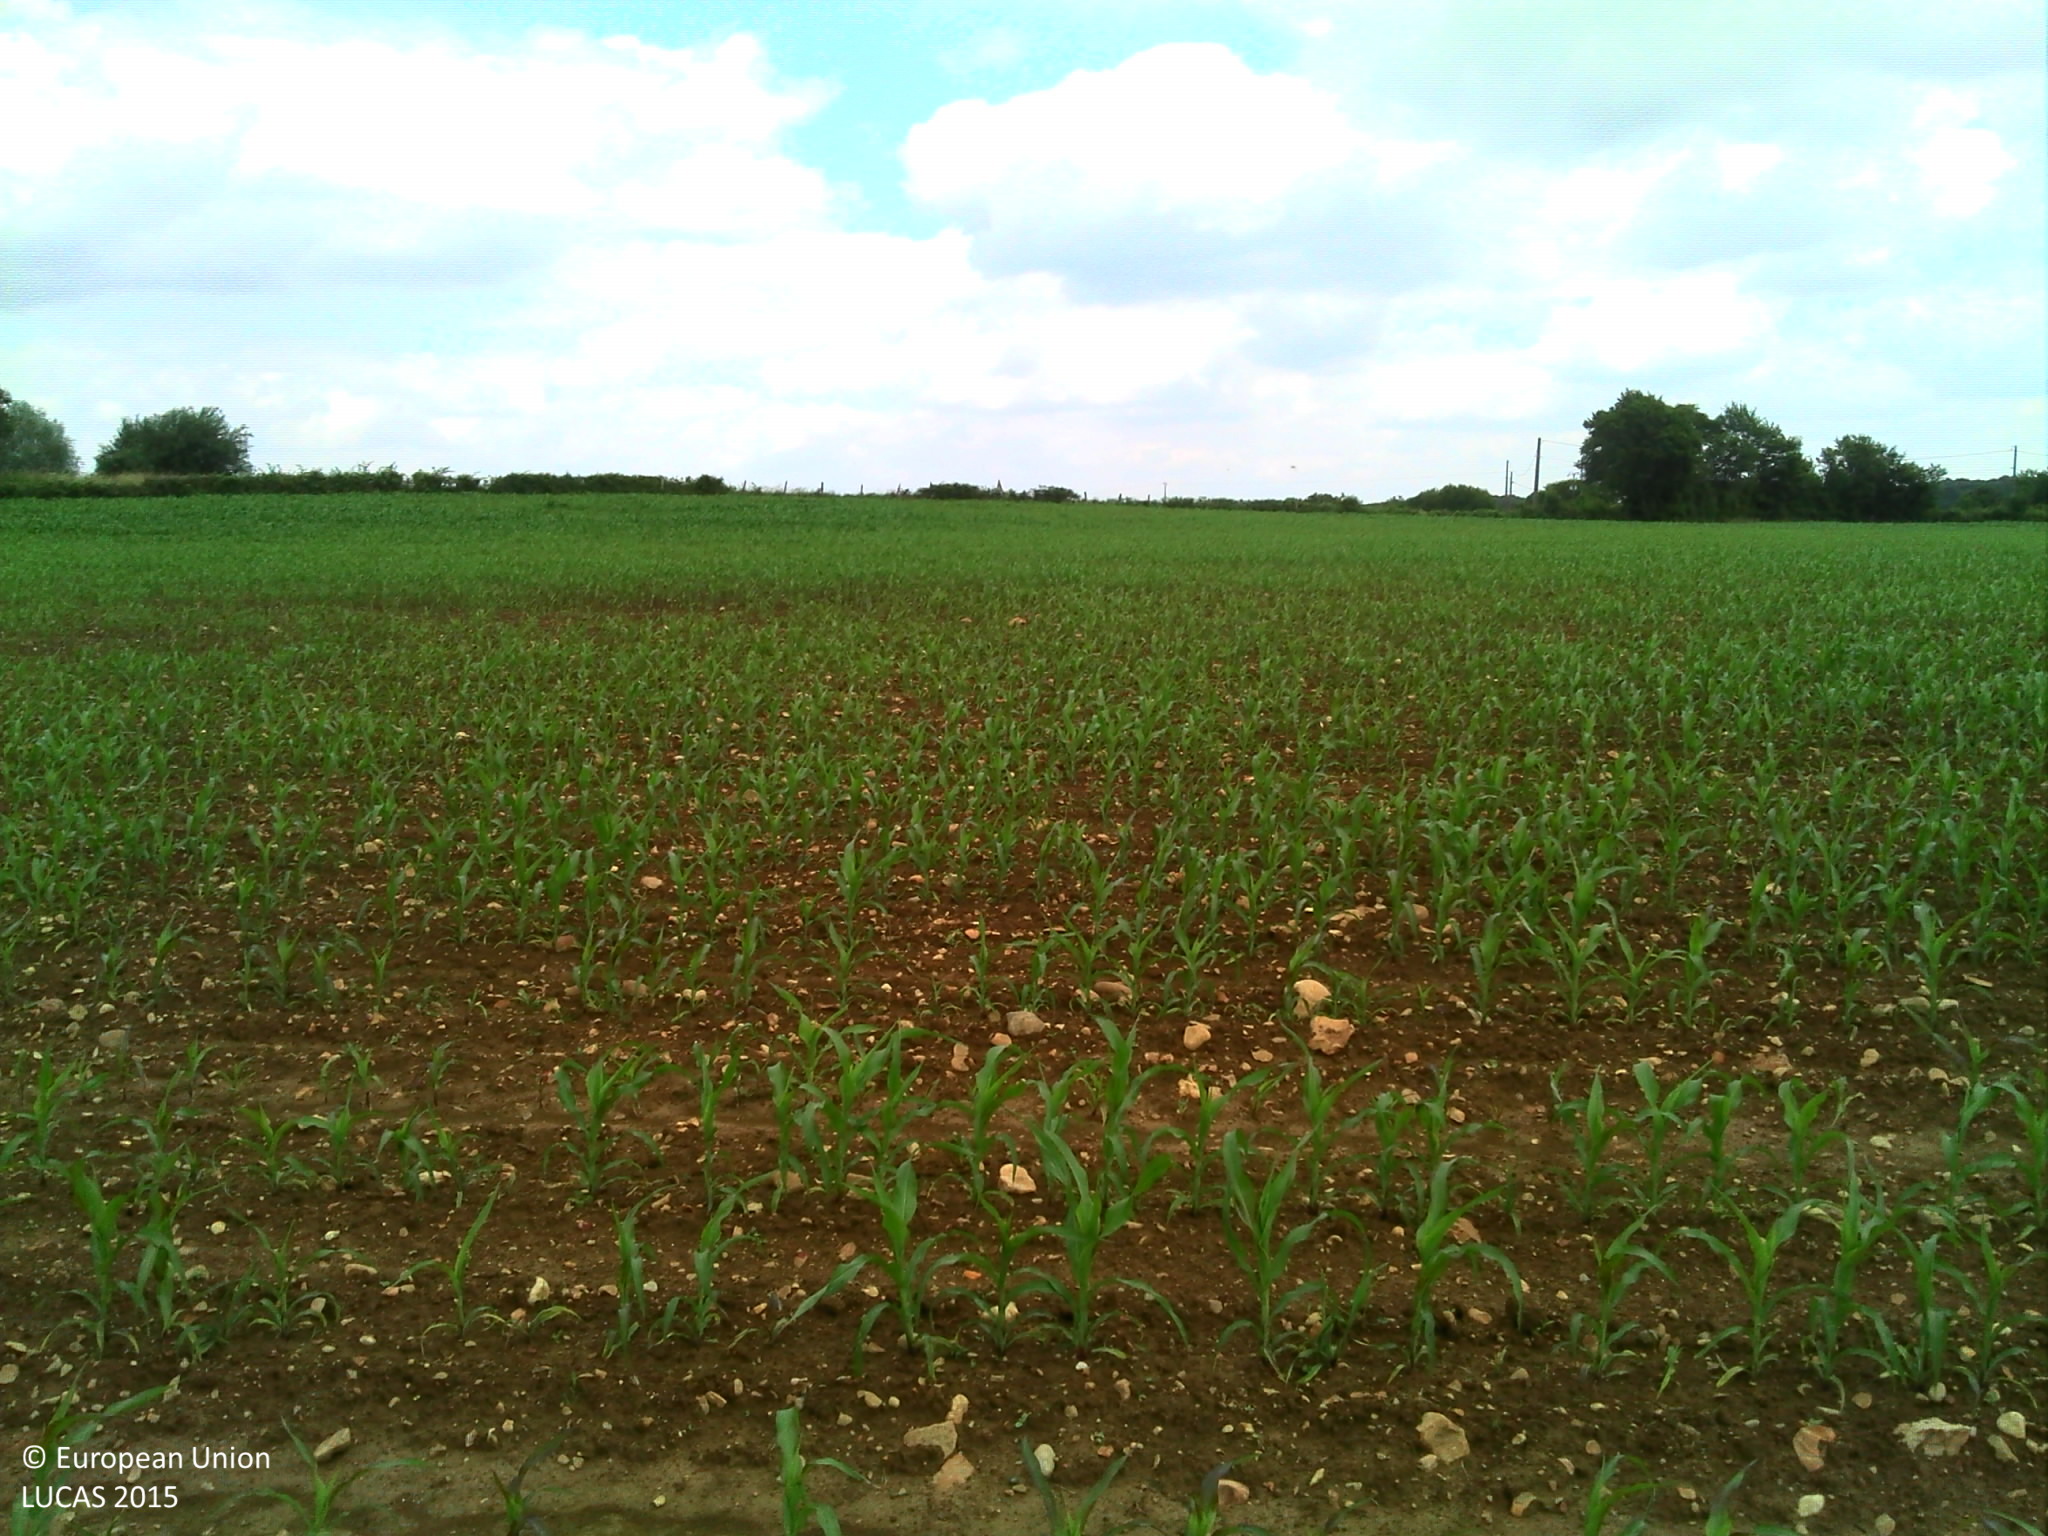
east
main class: Cropland
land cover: Maize
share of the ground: 10 - 25 %
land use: Agriculture (excluding fallow land and kitchen gardens)
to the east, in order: Maize; Fences; Managed hedges; Electric lines; Paved roads, cycling and walking lanes; Managed hedges; Fences; Grassland without tree/shrub cover
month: June
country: FR
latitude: 47.4839
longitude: 3.1070
